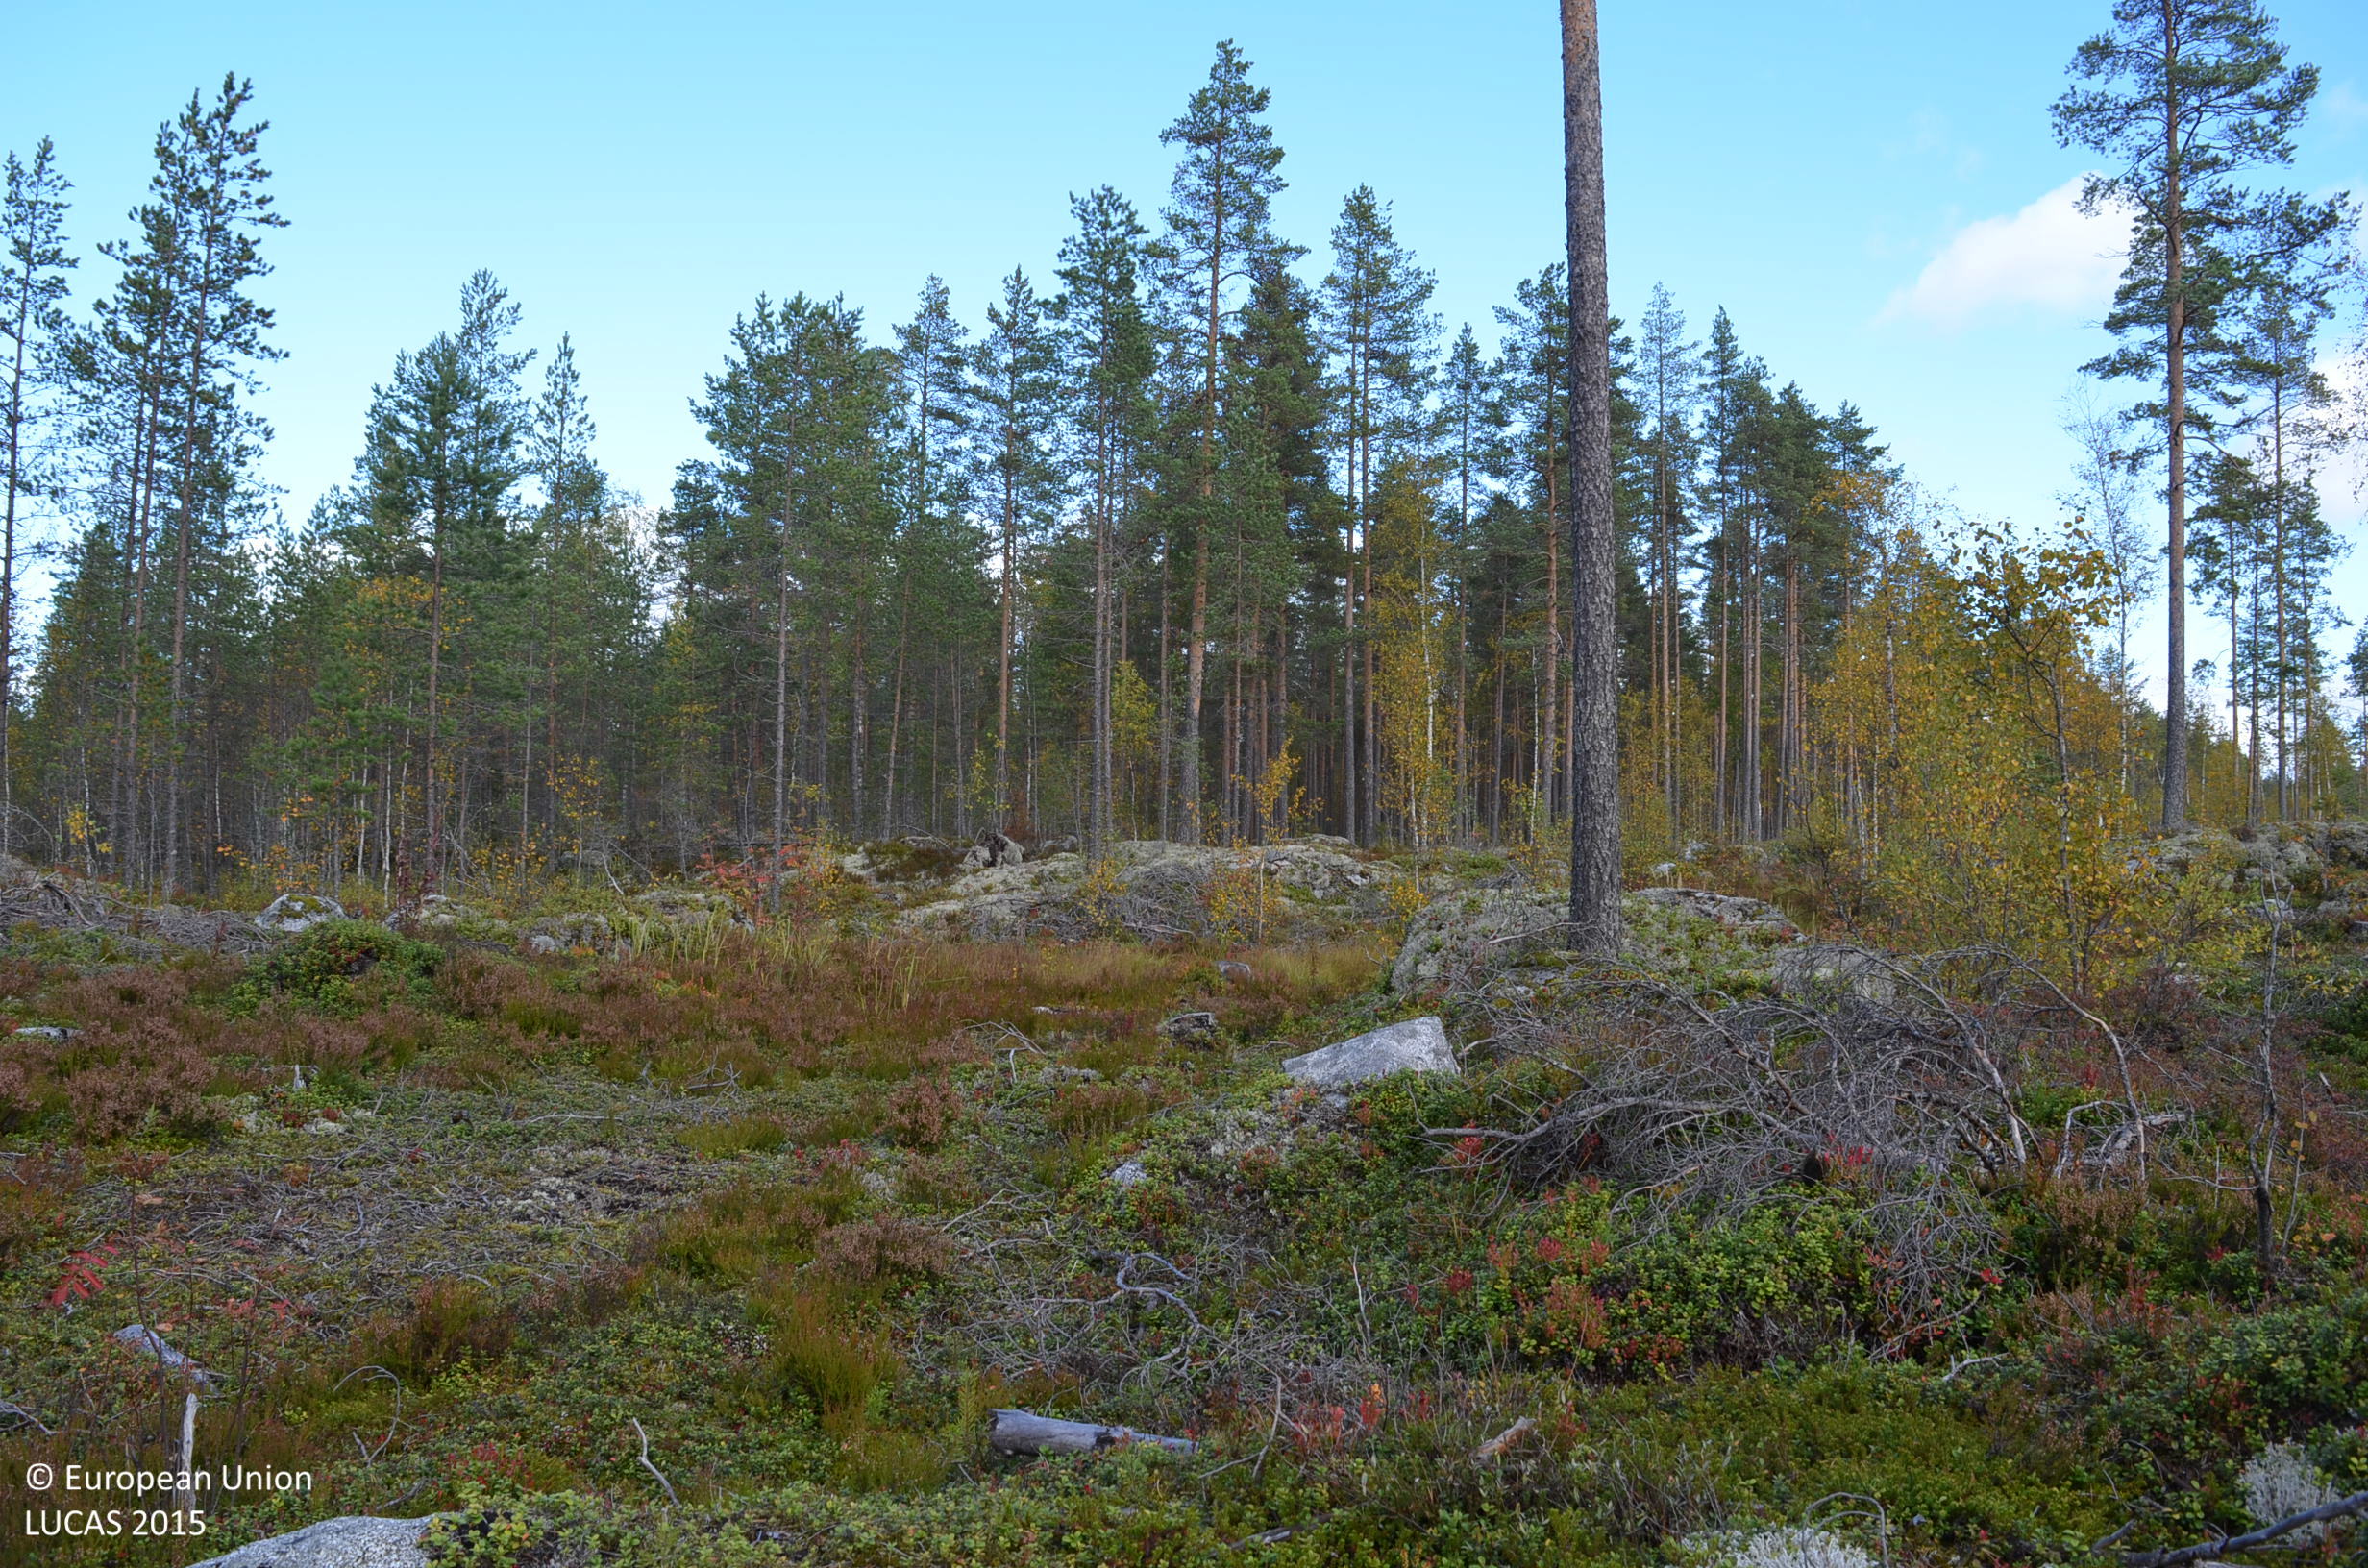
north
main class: Woodland
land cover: Broadleaved woodland
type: boreal forest
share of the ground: 25 - 50 %
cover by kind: shrubs 60 %, broadleaved forest trees 20 %, unconsolidated bare surface 15 %, coniferous forest trees 5 %
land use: Forestry
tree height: < 5 m
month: September
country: FI
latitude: 62.8925
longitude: 23.7834
